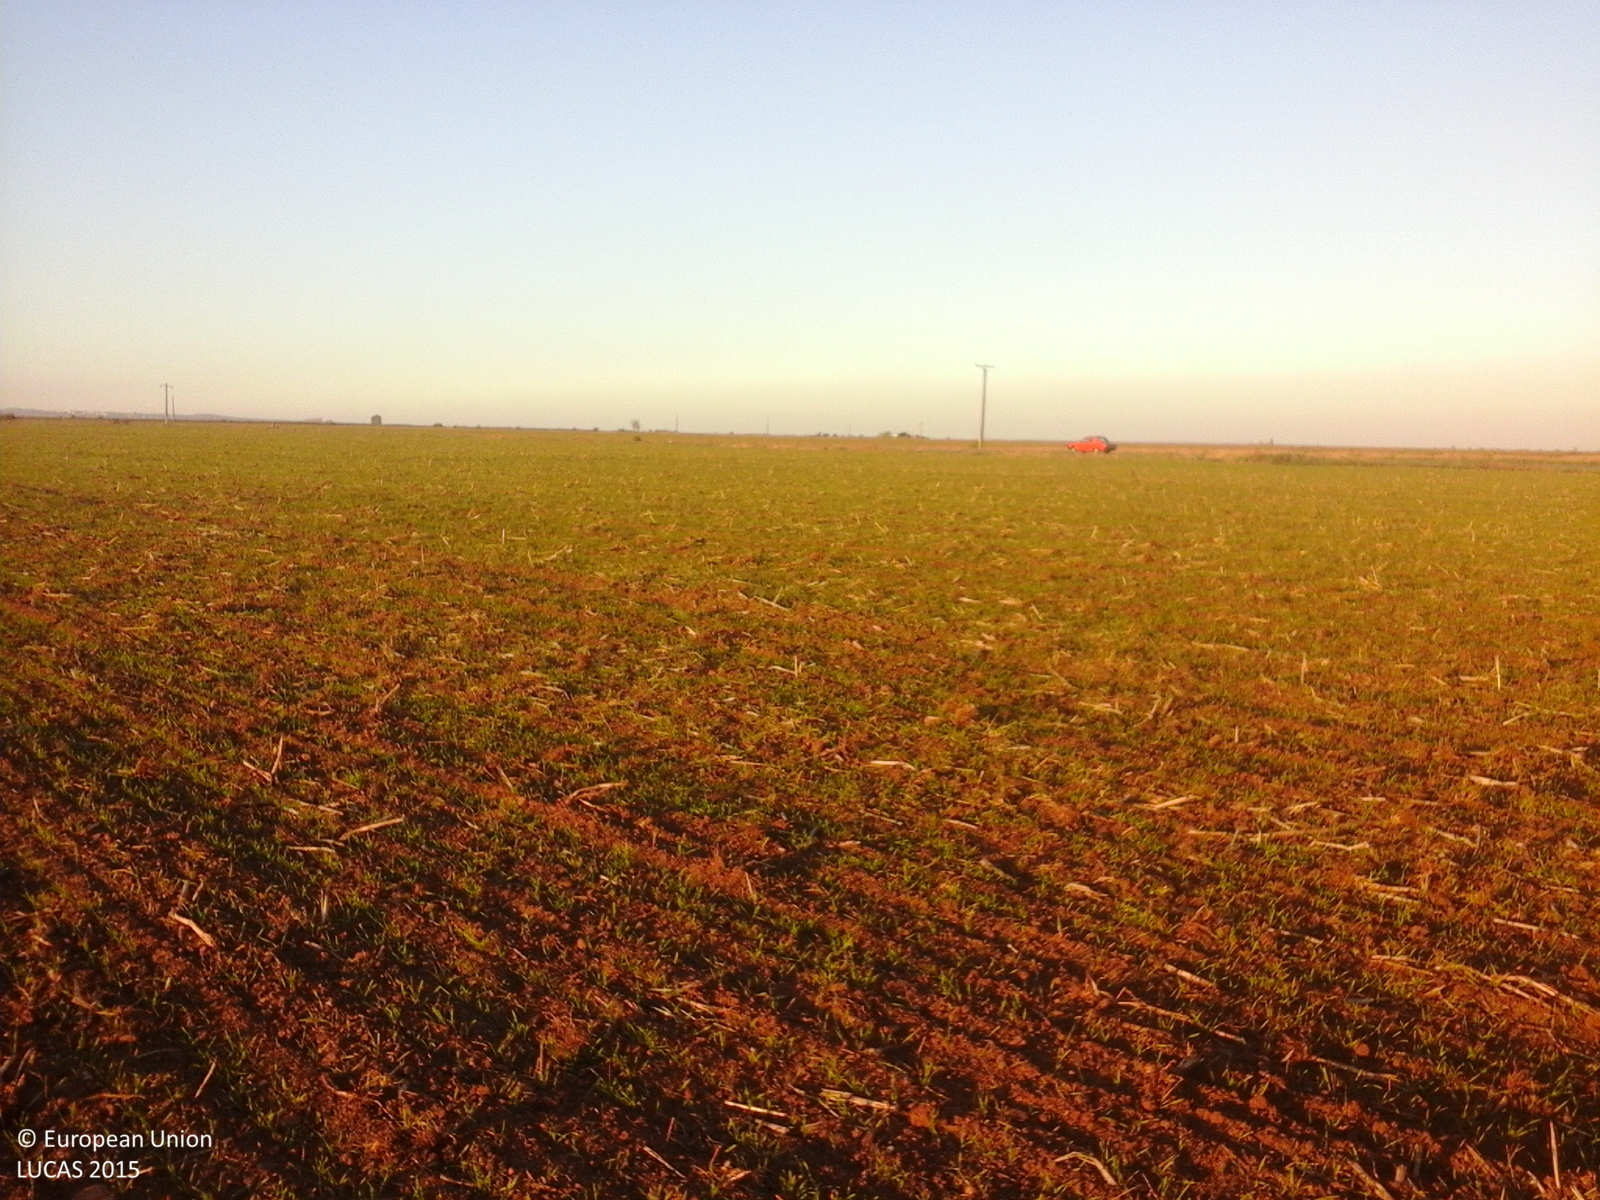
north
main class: Cropland
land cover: Common wheat
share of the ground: 10 - 25 %
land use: Agriculture (excluding fallow land and kitchen gardens)
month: October
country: RO
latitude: 45.7869
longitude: 27.1114
